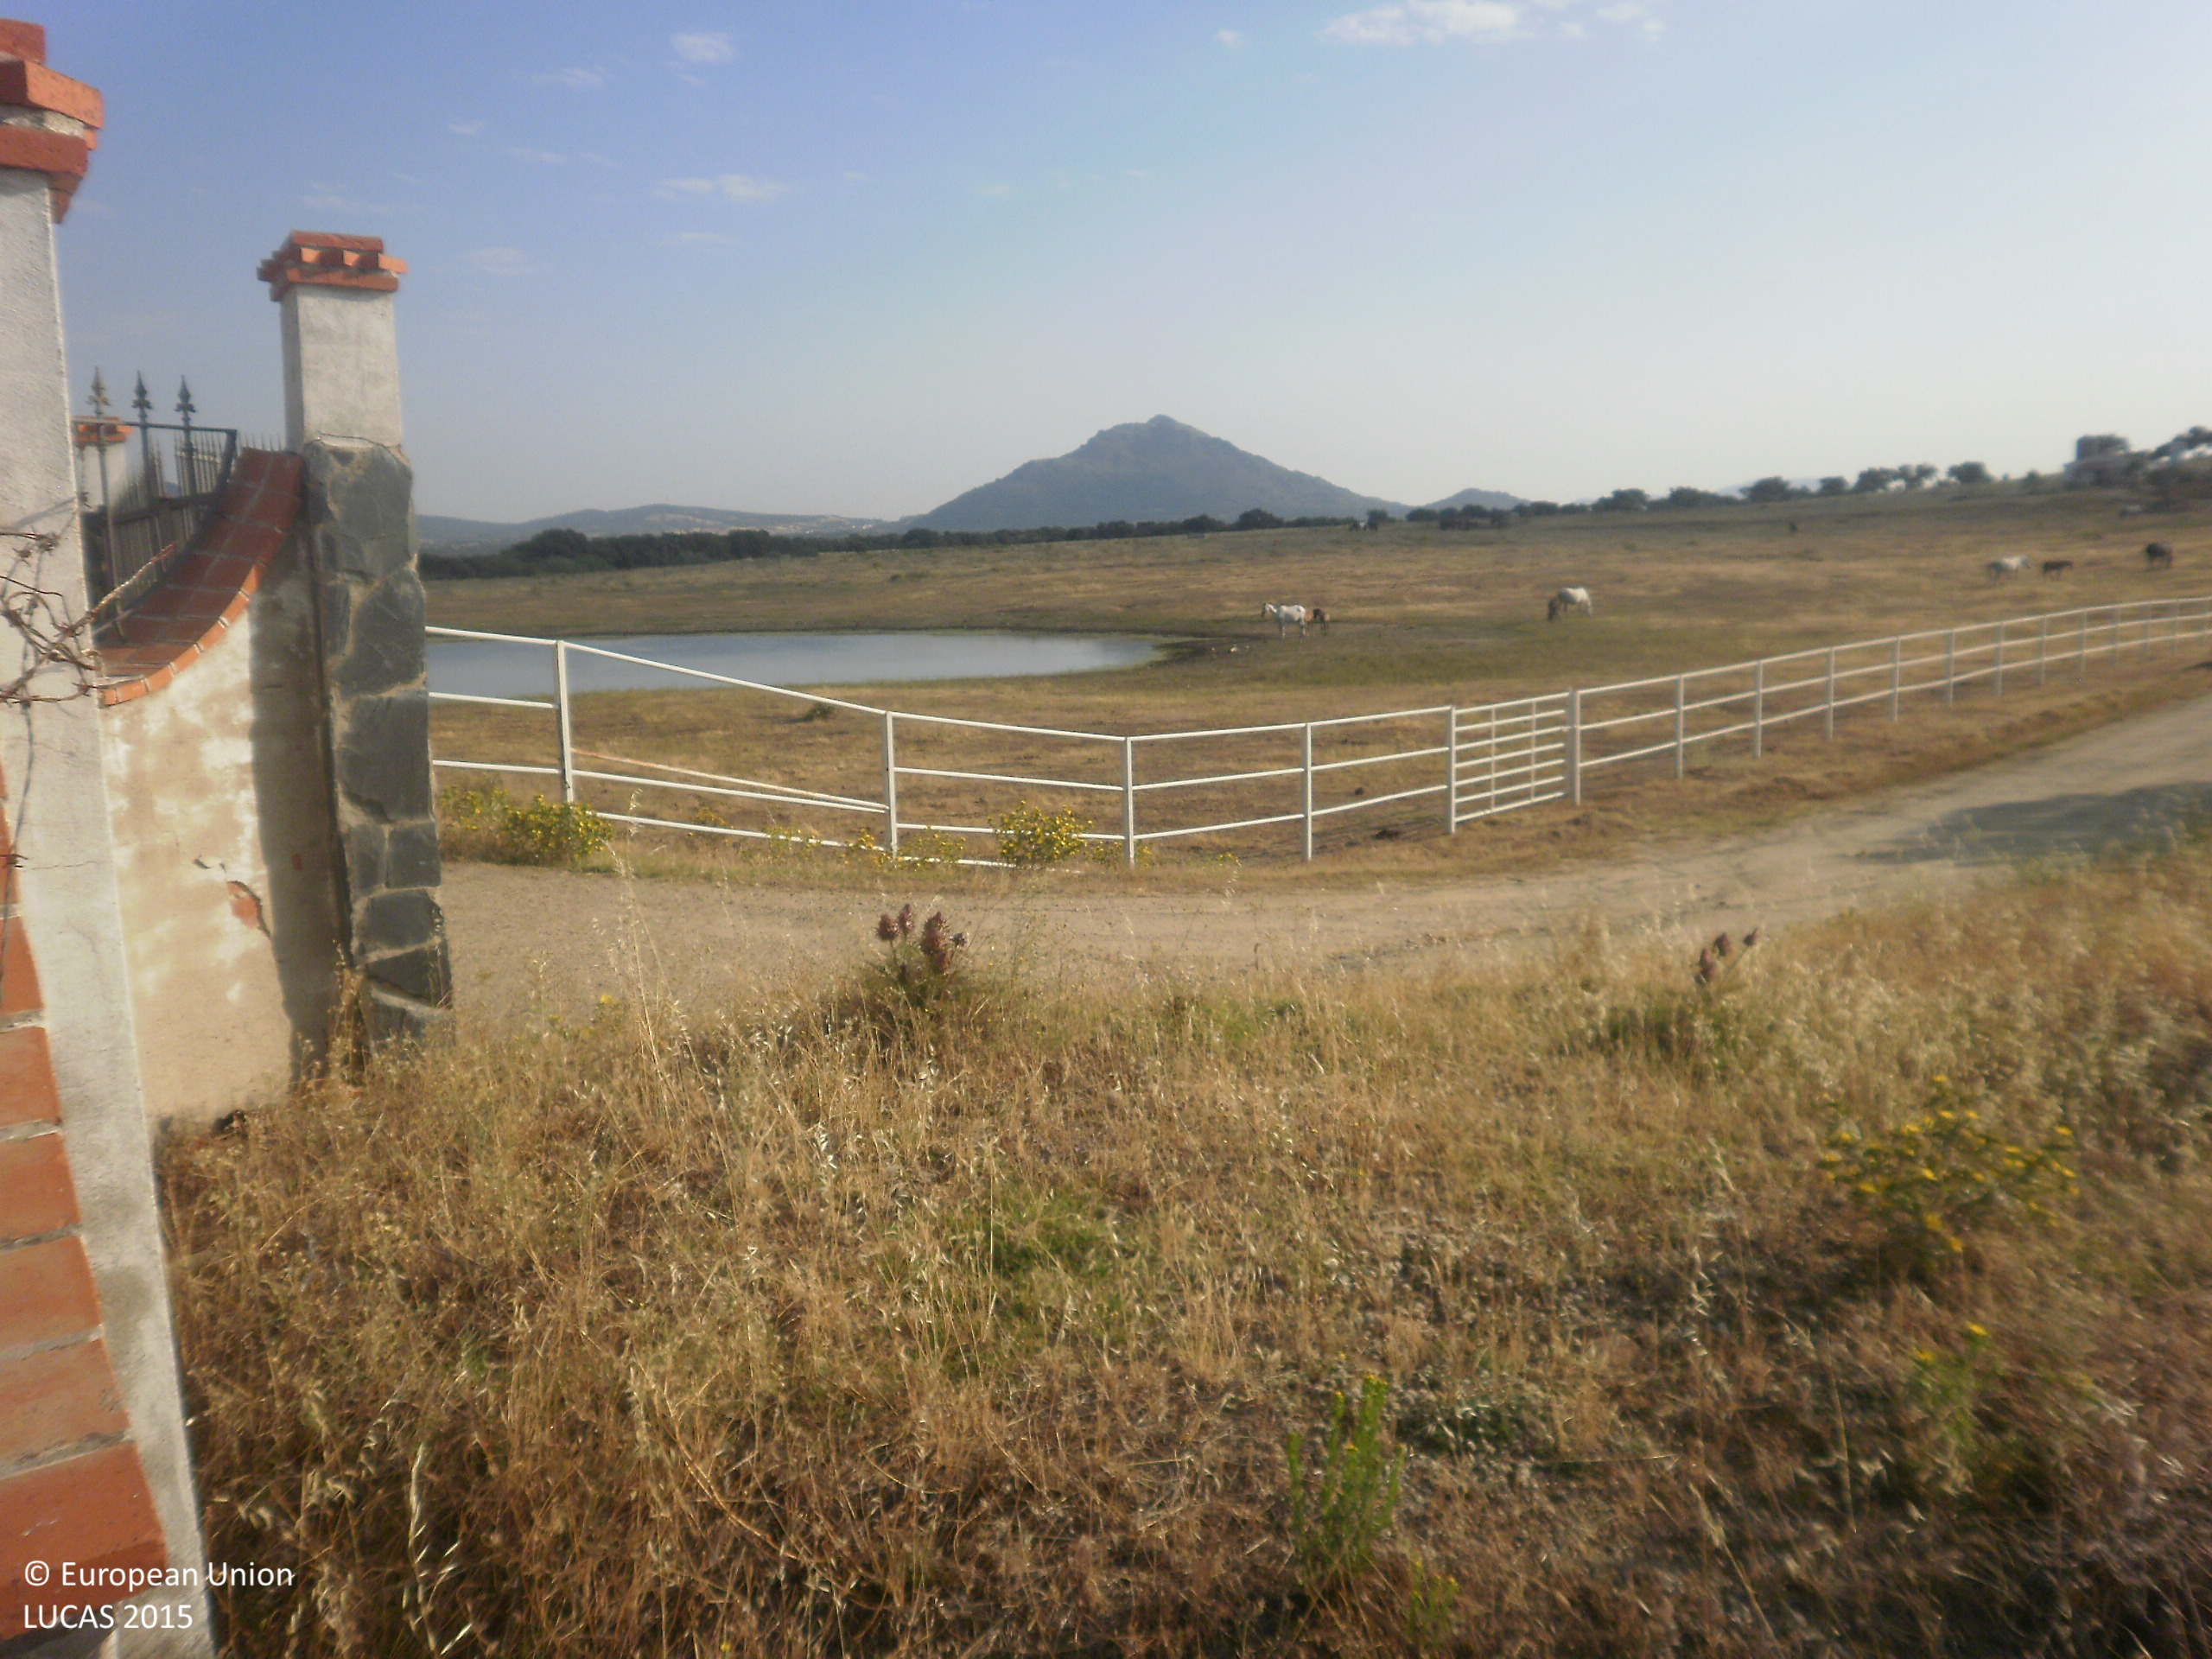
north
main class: Grassland
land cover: Grassland without tree/shrub cover
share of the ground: > 75 %
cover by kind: herbaceous plants 100 %
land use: Agriculture (excluding fallow land and kitchen gardens)
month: June
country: ES
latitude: 39.2638
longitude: -5.8513
